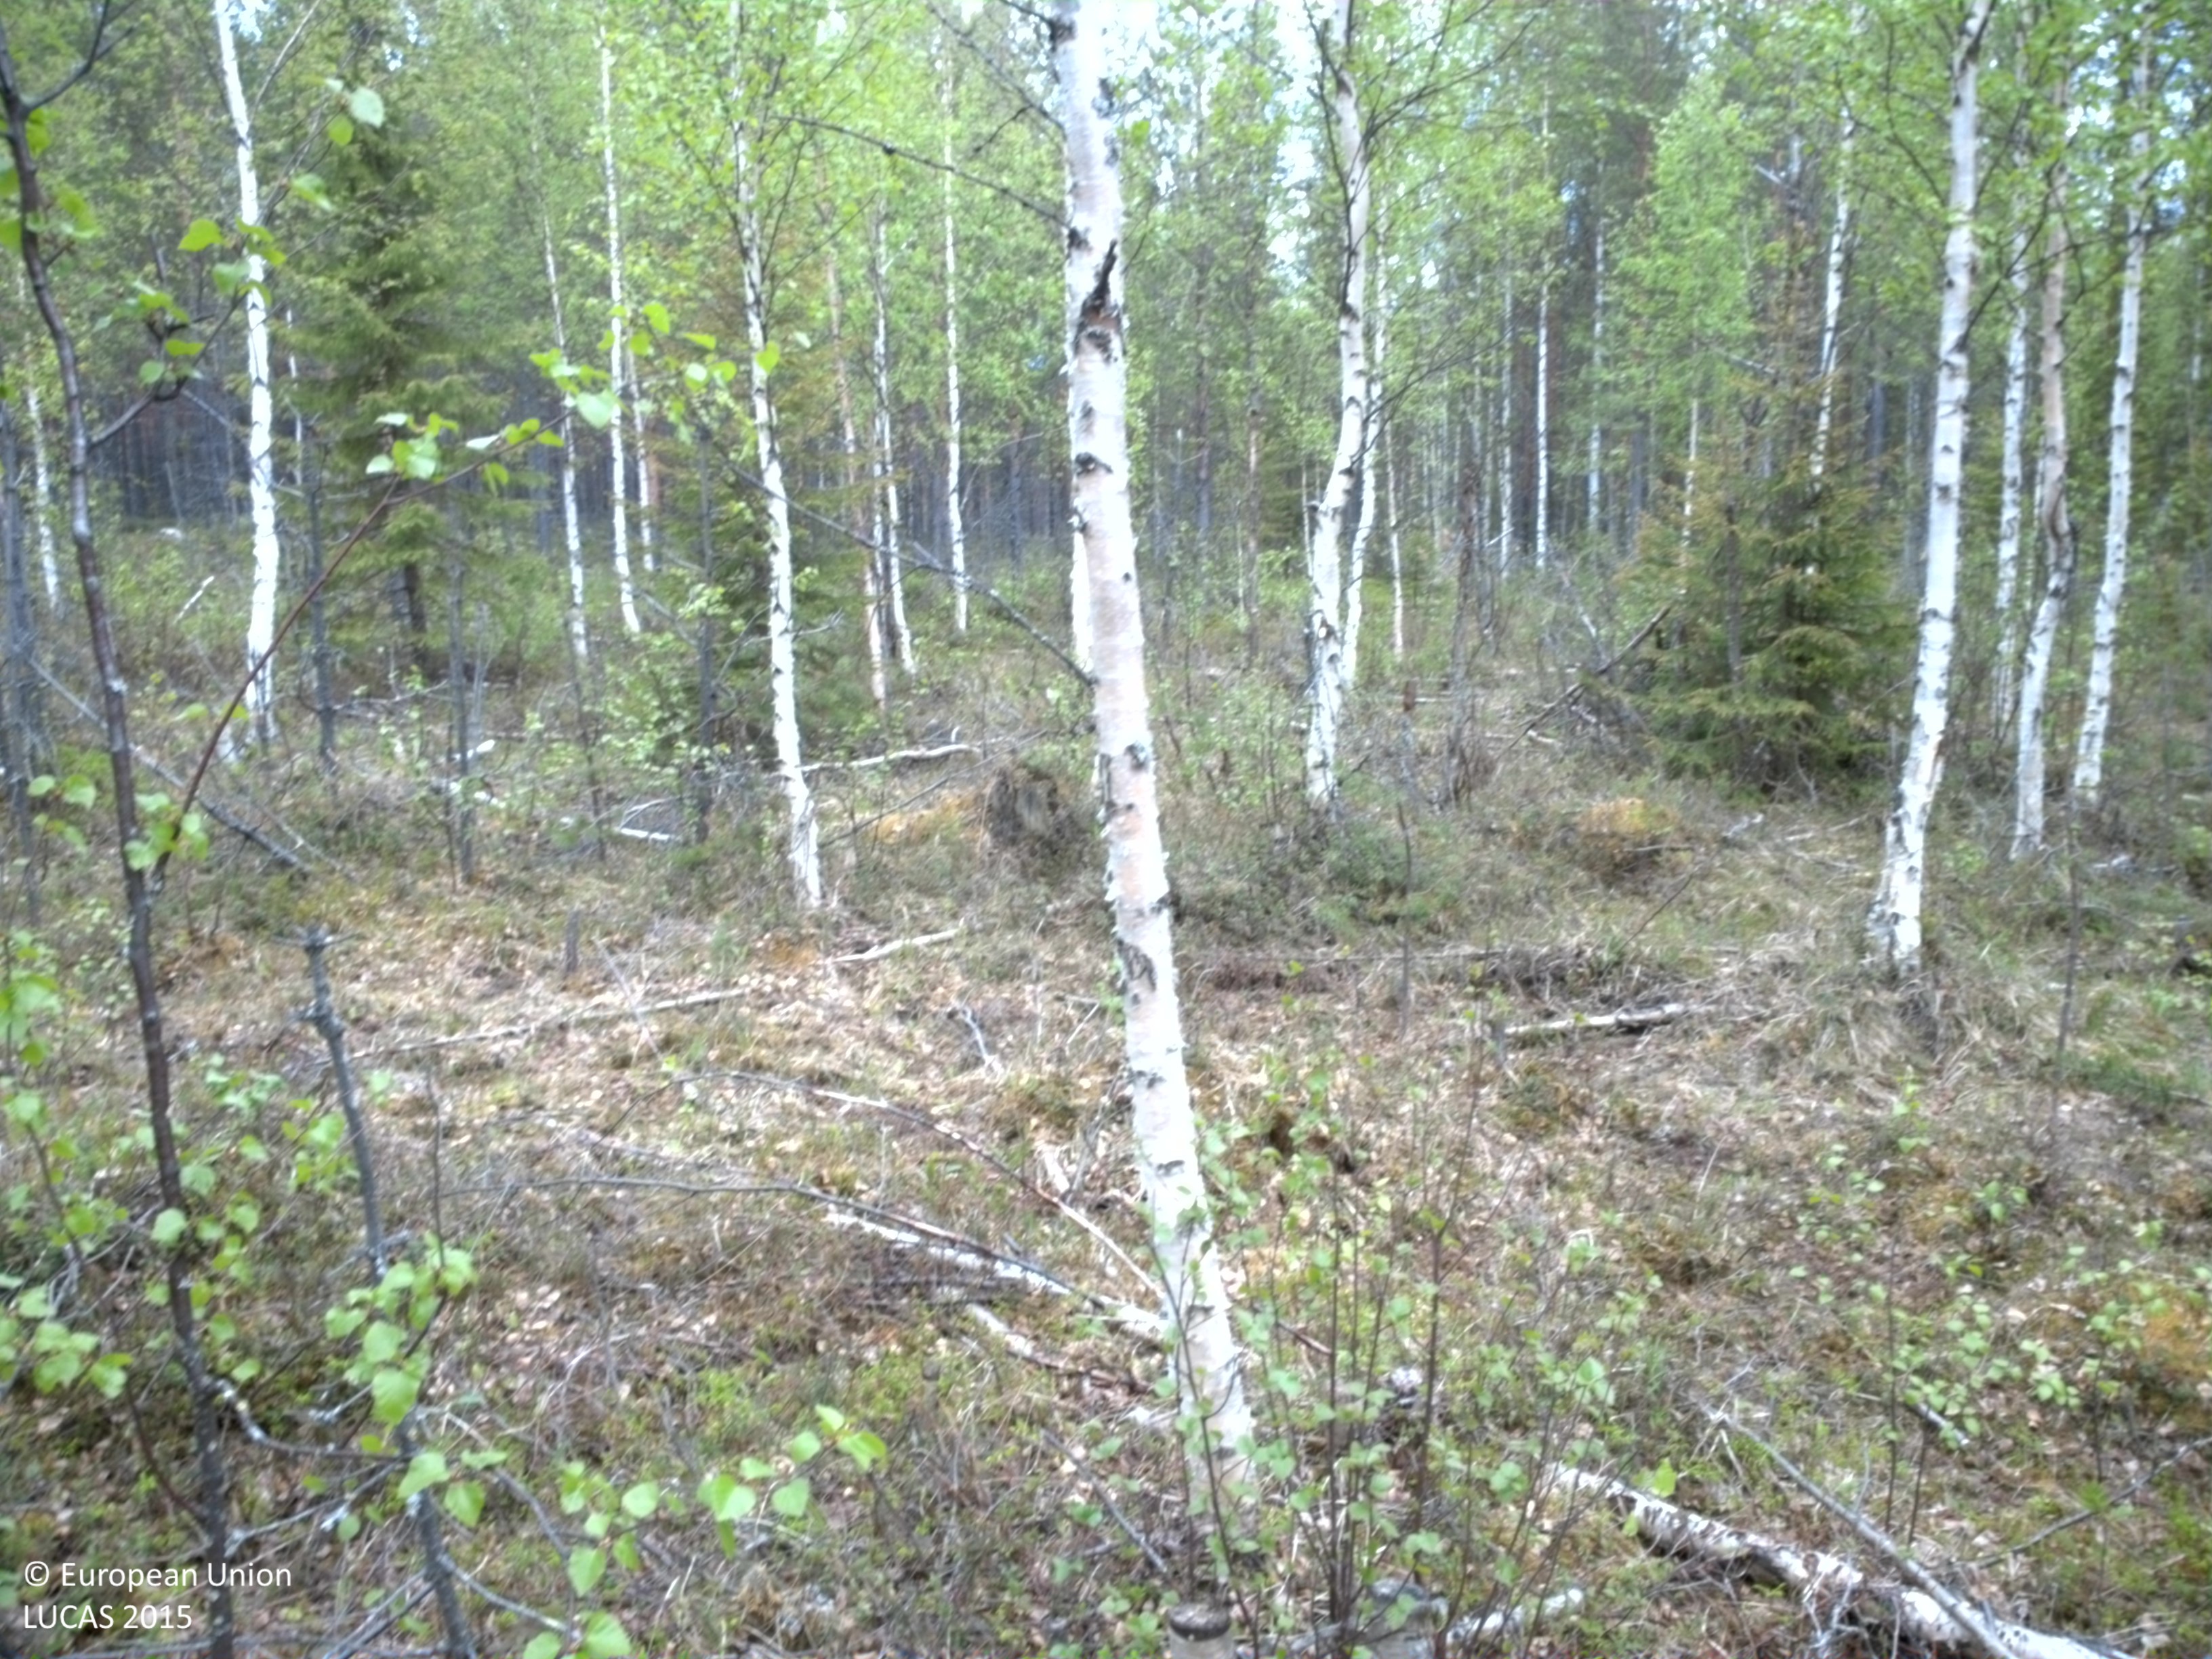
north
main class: Woodland
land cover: Broadleaved woodland
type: boreal forest
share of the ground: 50 - 75 %
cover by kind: broadleaved forest trees 70 %, shrubs 25 %, coniferous forest trees 5 %
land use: Forestry
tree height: > 5 m
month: June
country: SE
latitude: 66.5393
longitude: 22.3271
